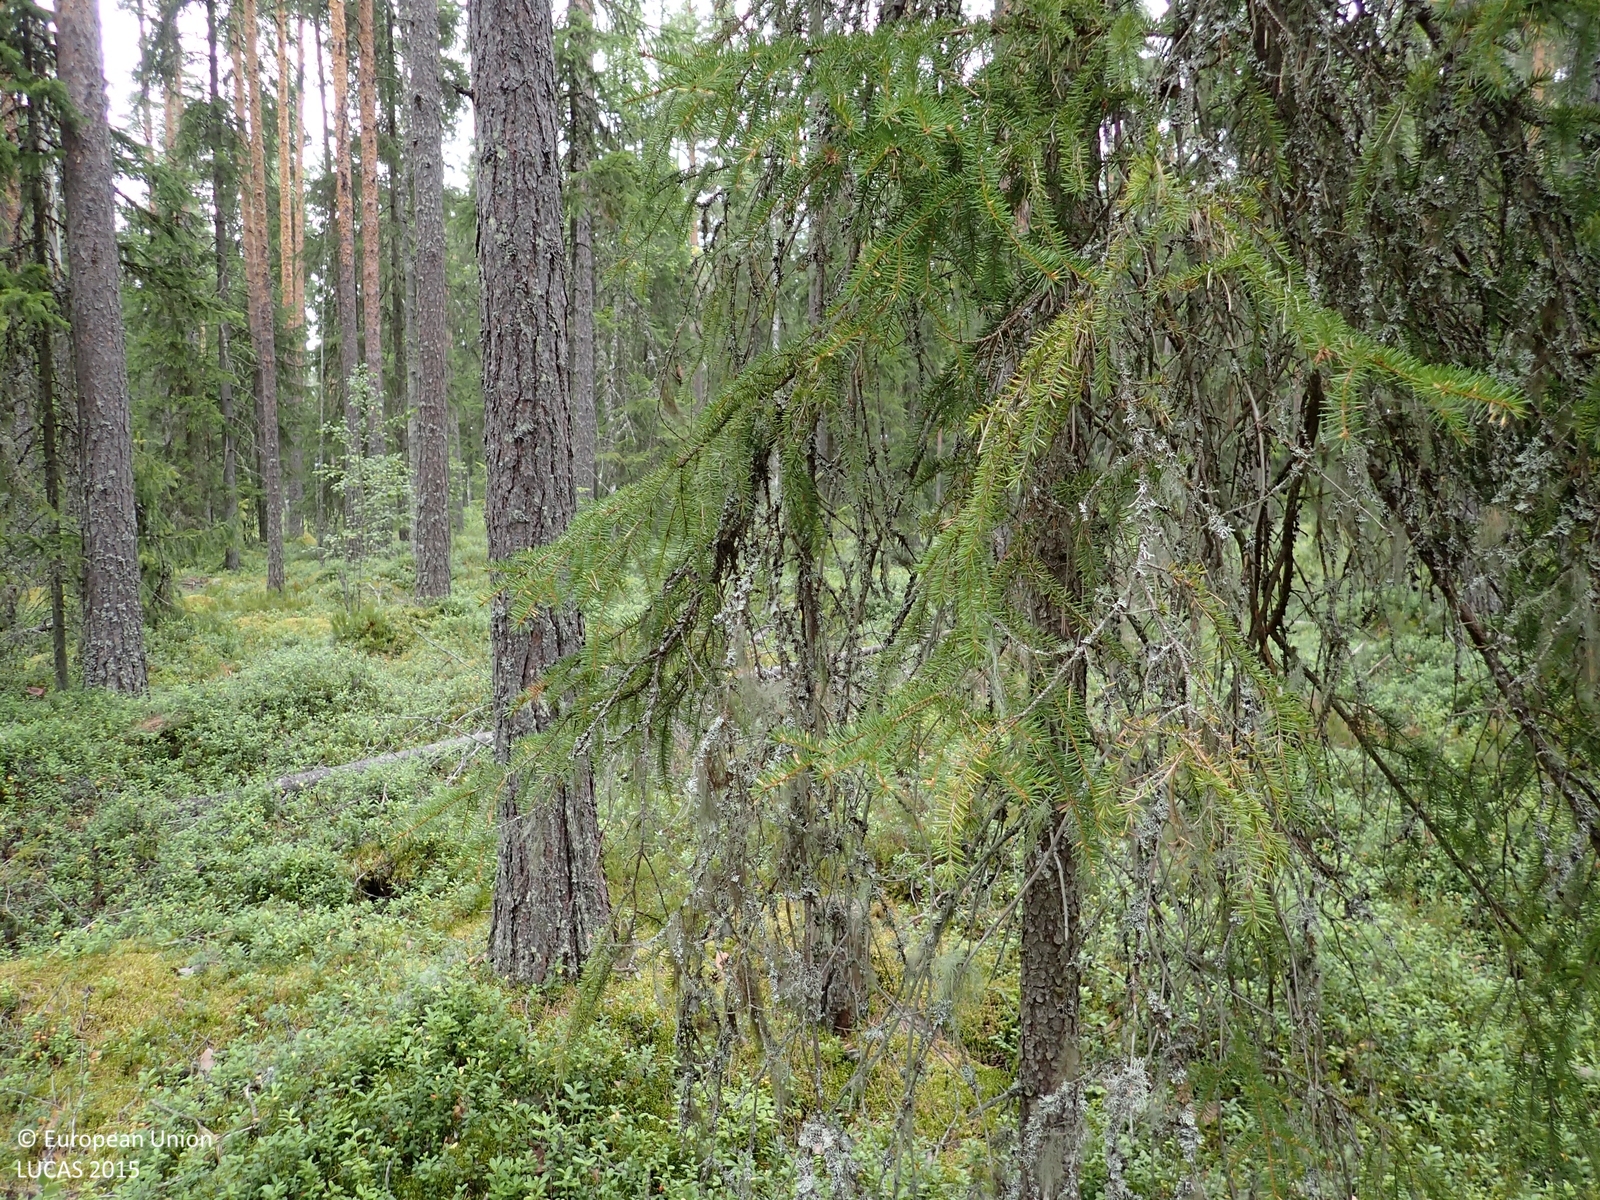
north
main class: Woodland
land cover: Other coniferous woodland
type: boreal forest
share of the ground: > 75 %
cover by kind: coniferous forest trees 70 %, shrubs 20 %, broadleaved forest trees 5 %, lichens and mosses 5 %
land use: Forestry
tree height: > 5 m
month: August
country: FI
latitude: 62.6592
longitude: 22.6842
